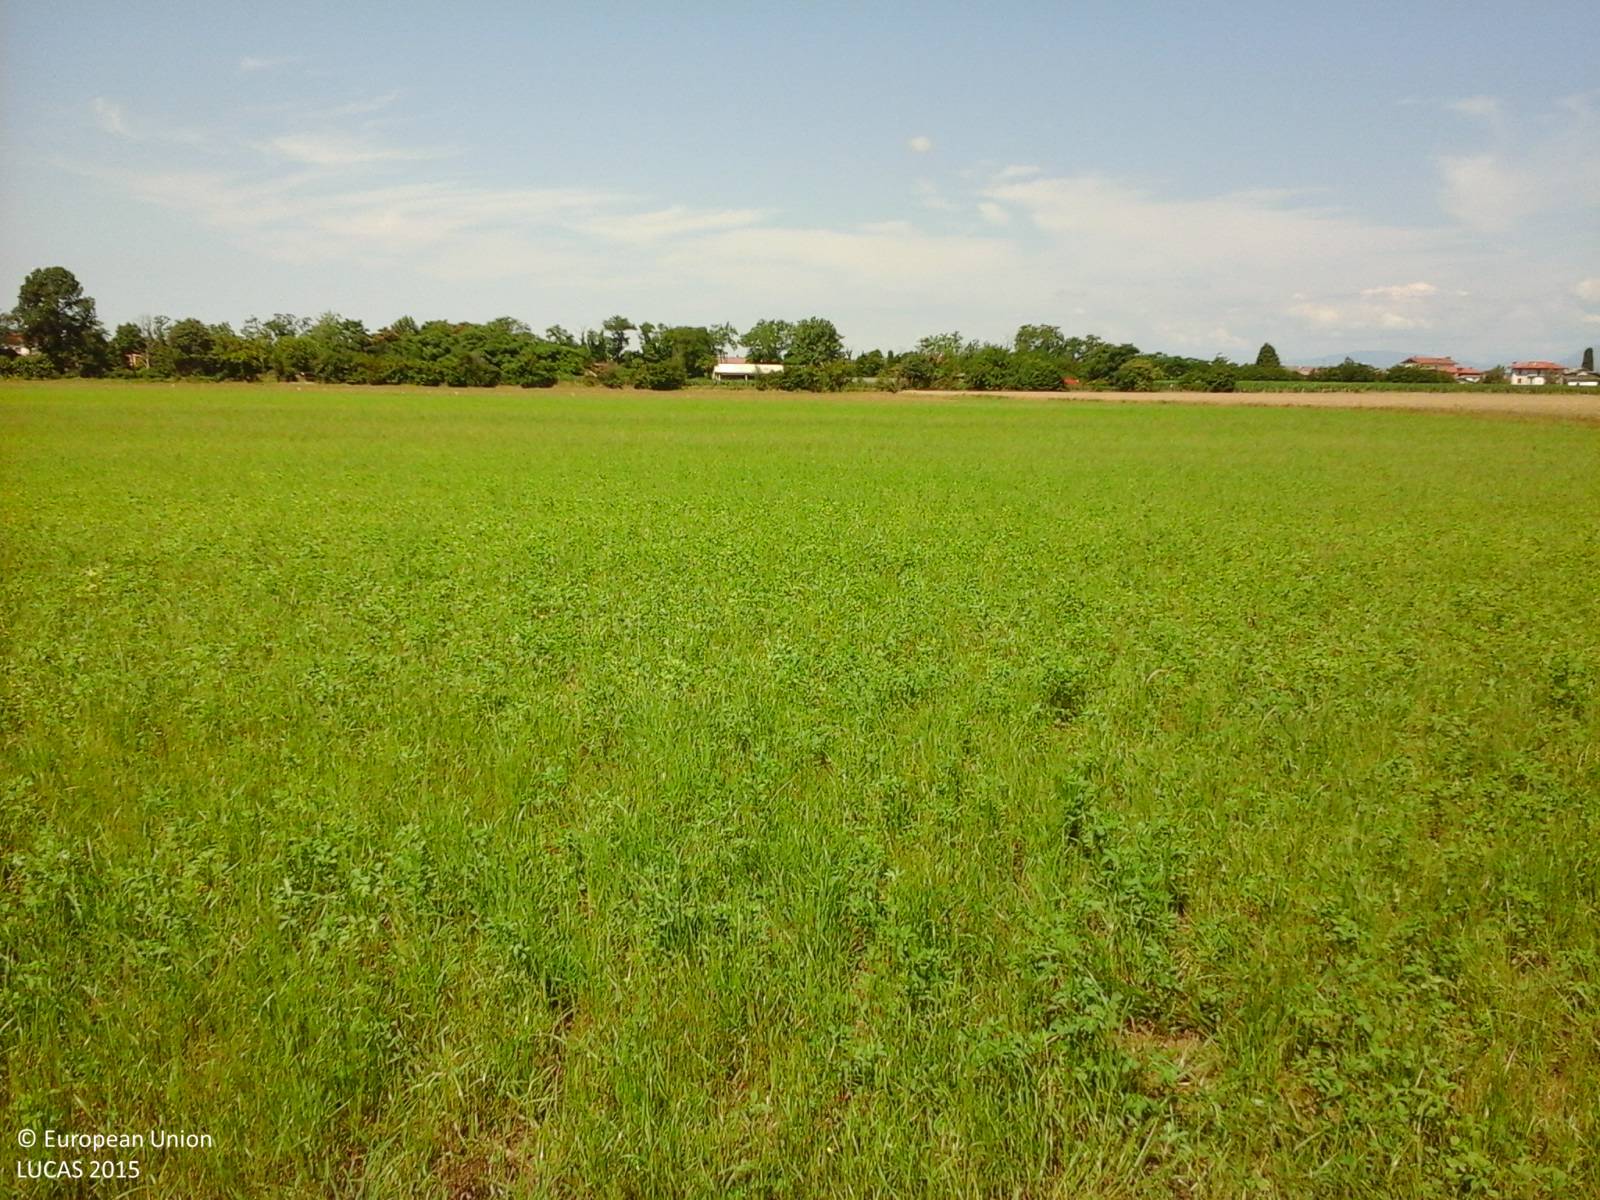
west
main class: Cropland
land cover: Lucerne
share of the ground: > 75 %
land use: Agriculture (excluding fallow land and kitchen gardens)
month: June
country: IT
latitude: 46.1037
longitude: 13.2436
